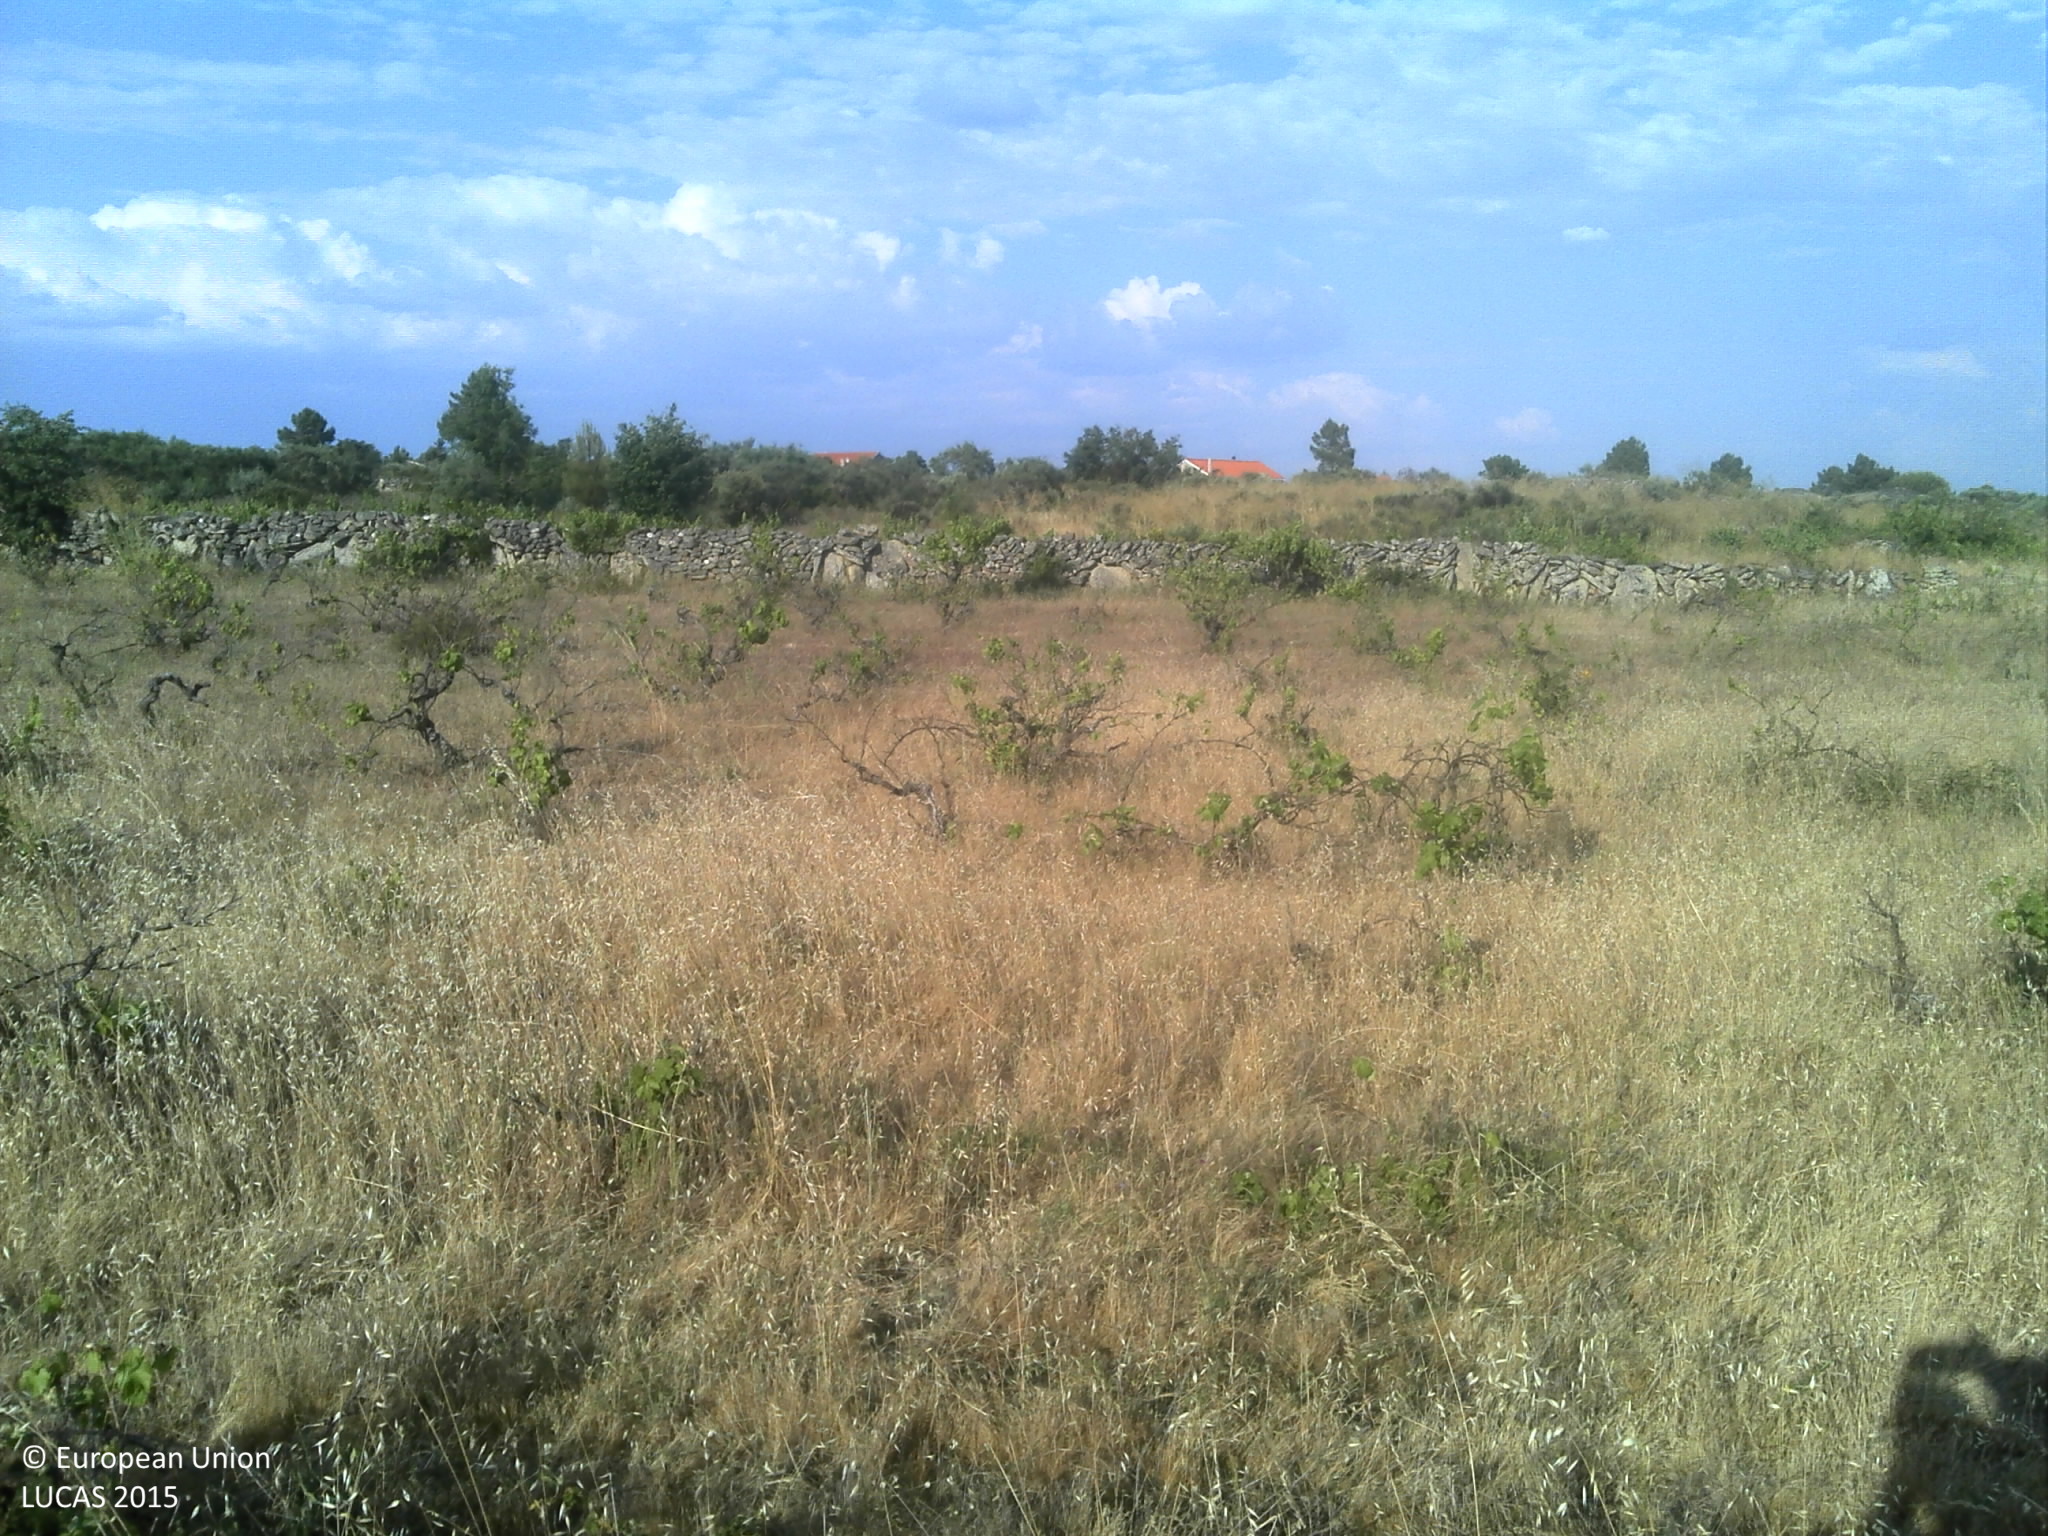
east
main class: Cropland
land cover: Vineyards
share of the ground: 10 - 25 %
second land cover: Grassland without tree/shrub cover
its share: 50 - 75 %
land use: Agriculture (excluding fallow land and kitchen gardens)
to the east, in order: Vineyards; Grassland without tree/shrub cover; Vineyards; Dry stone walls; Vineyards; Shrubland without tree cover; Rye; Single bushes/trees; Dry stone walls; Tracks; Dry stone walls; Grassland without tree/shrub cover
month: June
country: PT
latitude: 40.5029
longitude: -7.0089
